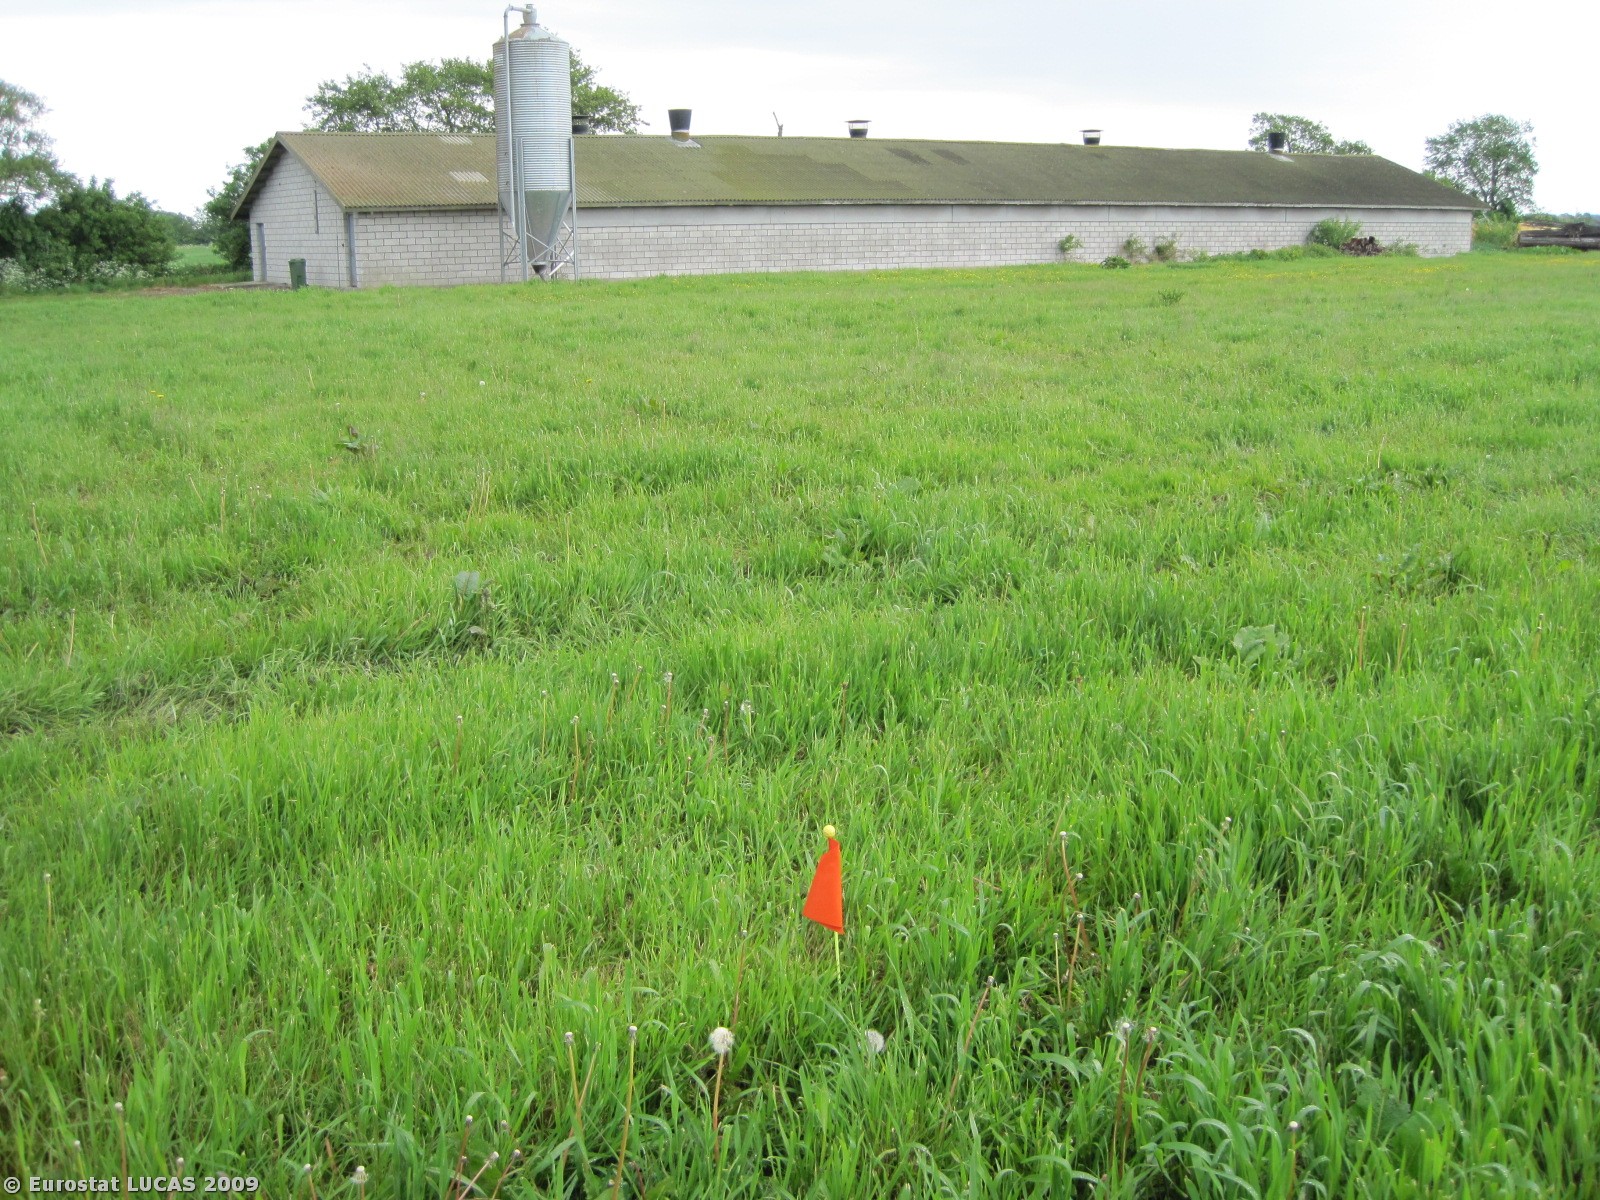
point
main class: Grassland
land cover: Grassland without tree/shrub cover
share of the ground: > 75 %
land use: Agriculture (excluding fallow land and kitchen gardens)
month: May
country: DK
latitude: 56.7808
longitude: 10.2125
